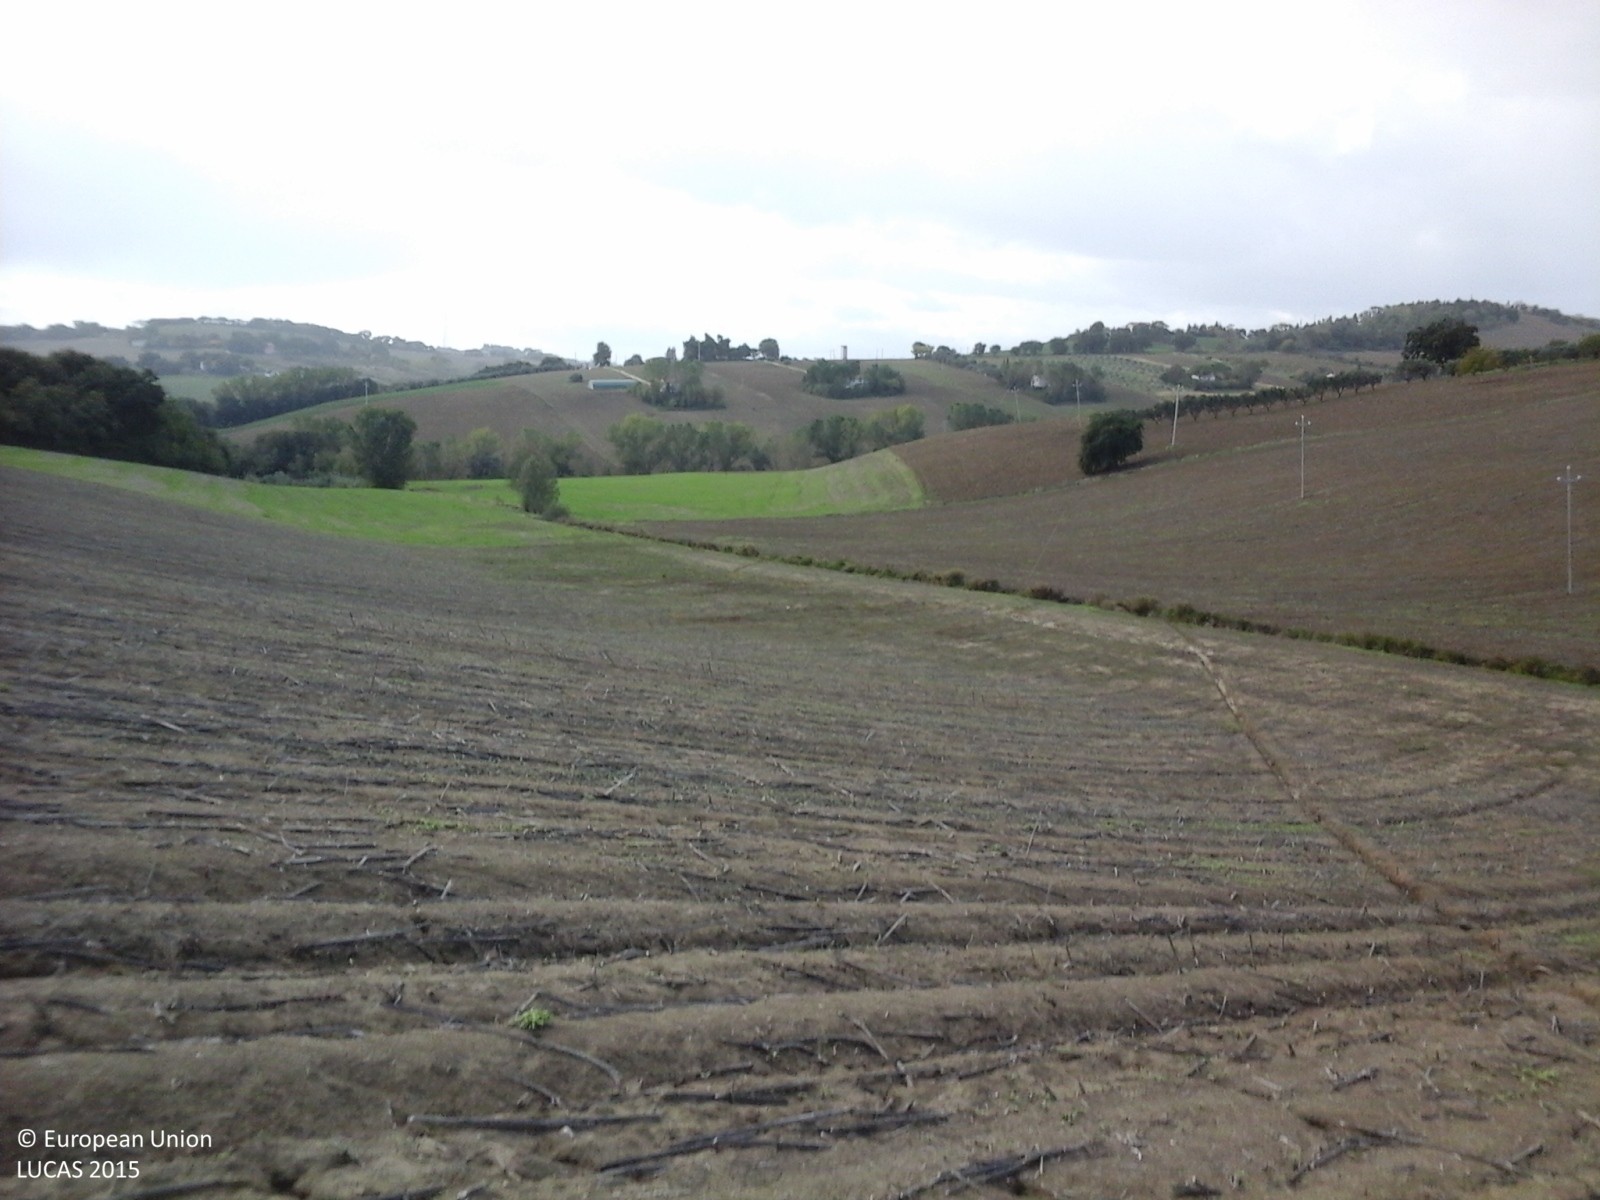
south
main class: Cropland
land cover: Sunflower
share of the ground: < 10 %
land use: Agriculture (excluding fallow land and kitchen gardens)
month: October
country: IT
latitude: 43.6332
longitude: 13.2025
